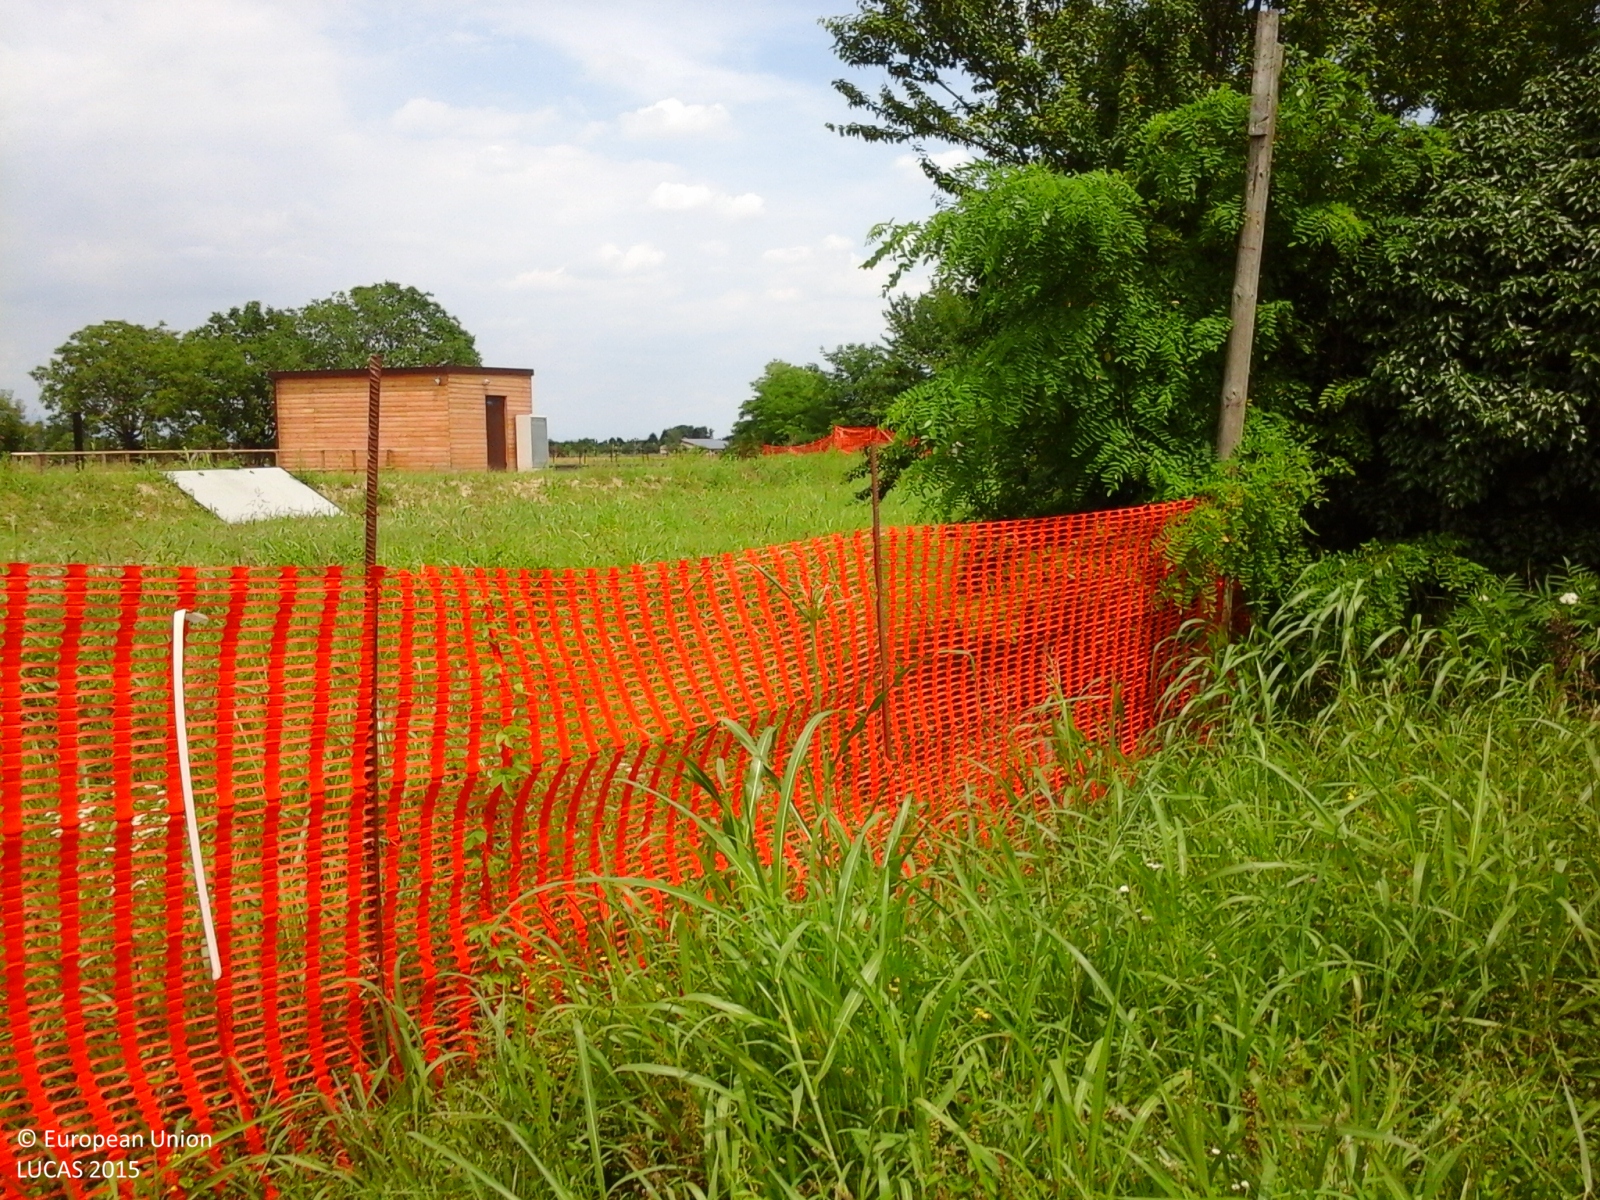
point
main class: Grassland
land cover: Grassland without tree/shrub cover
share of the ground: > 75 %
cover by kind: herbaceous plants 100 %
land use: Residential
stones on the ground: > 50 %
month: June
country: IT
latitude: 45.9451
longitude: 12.4348
